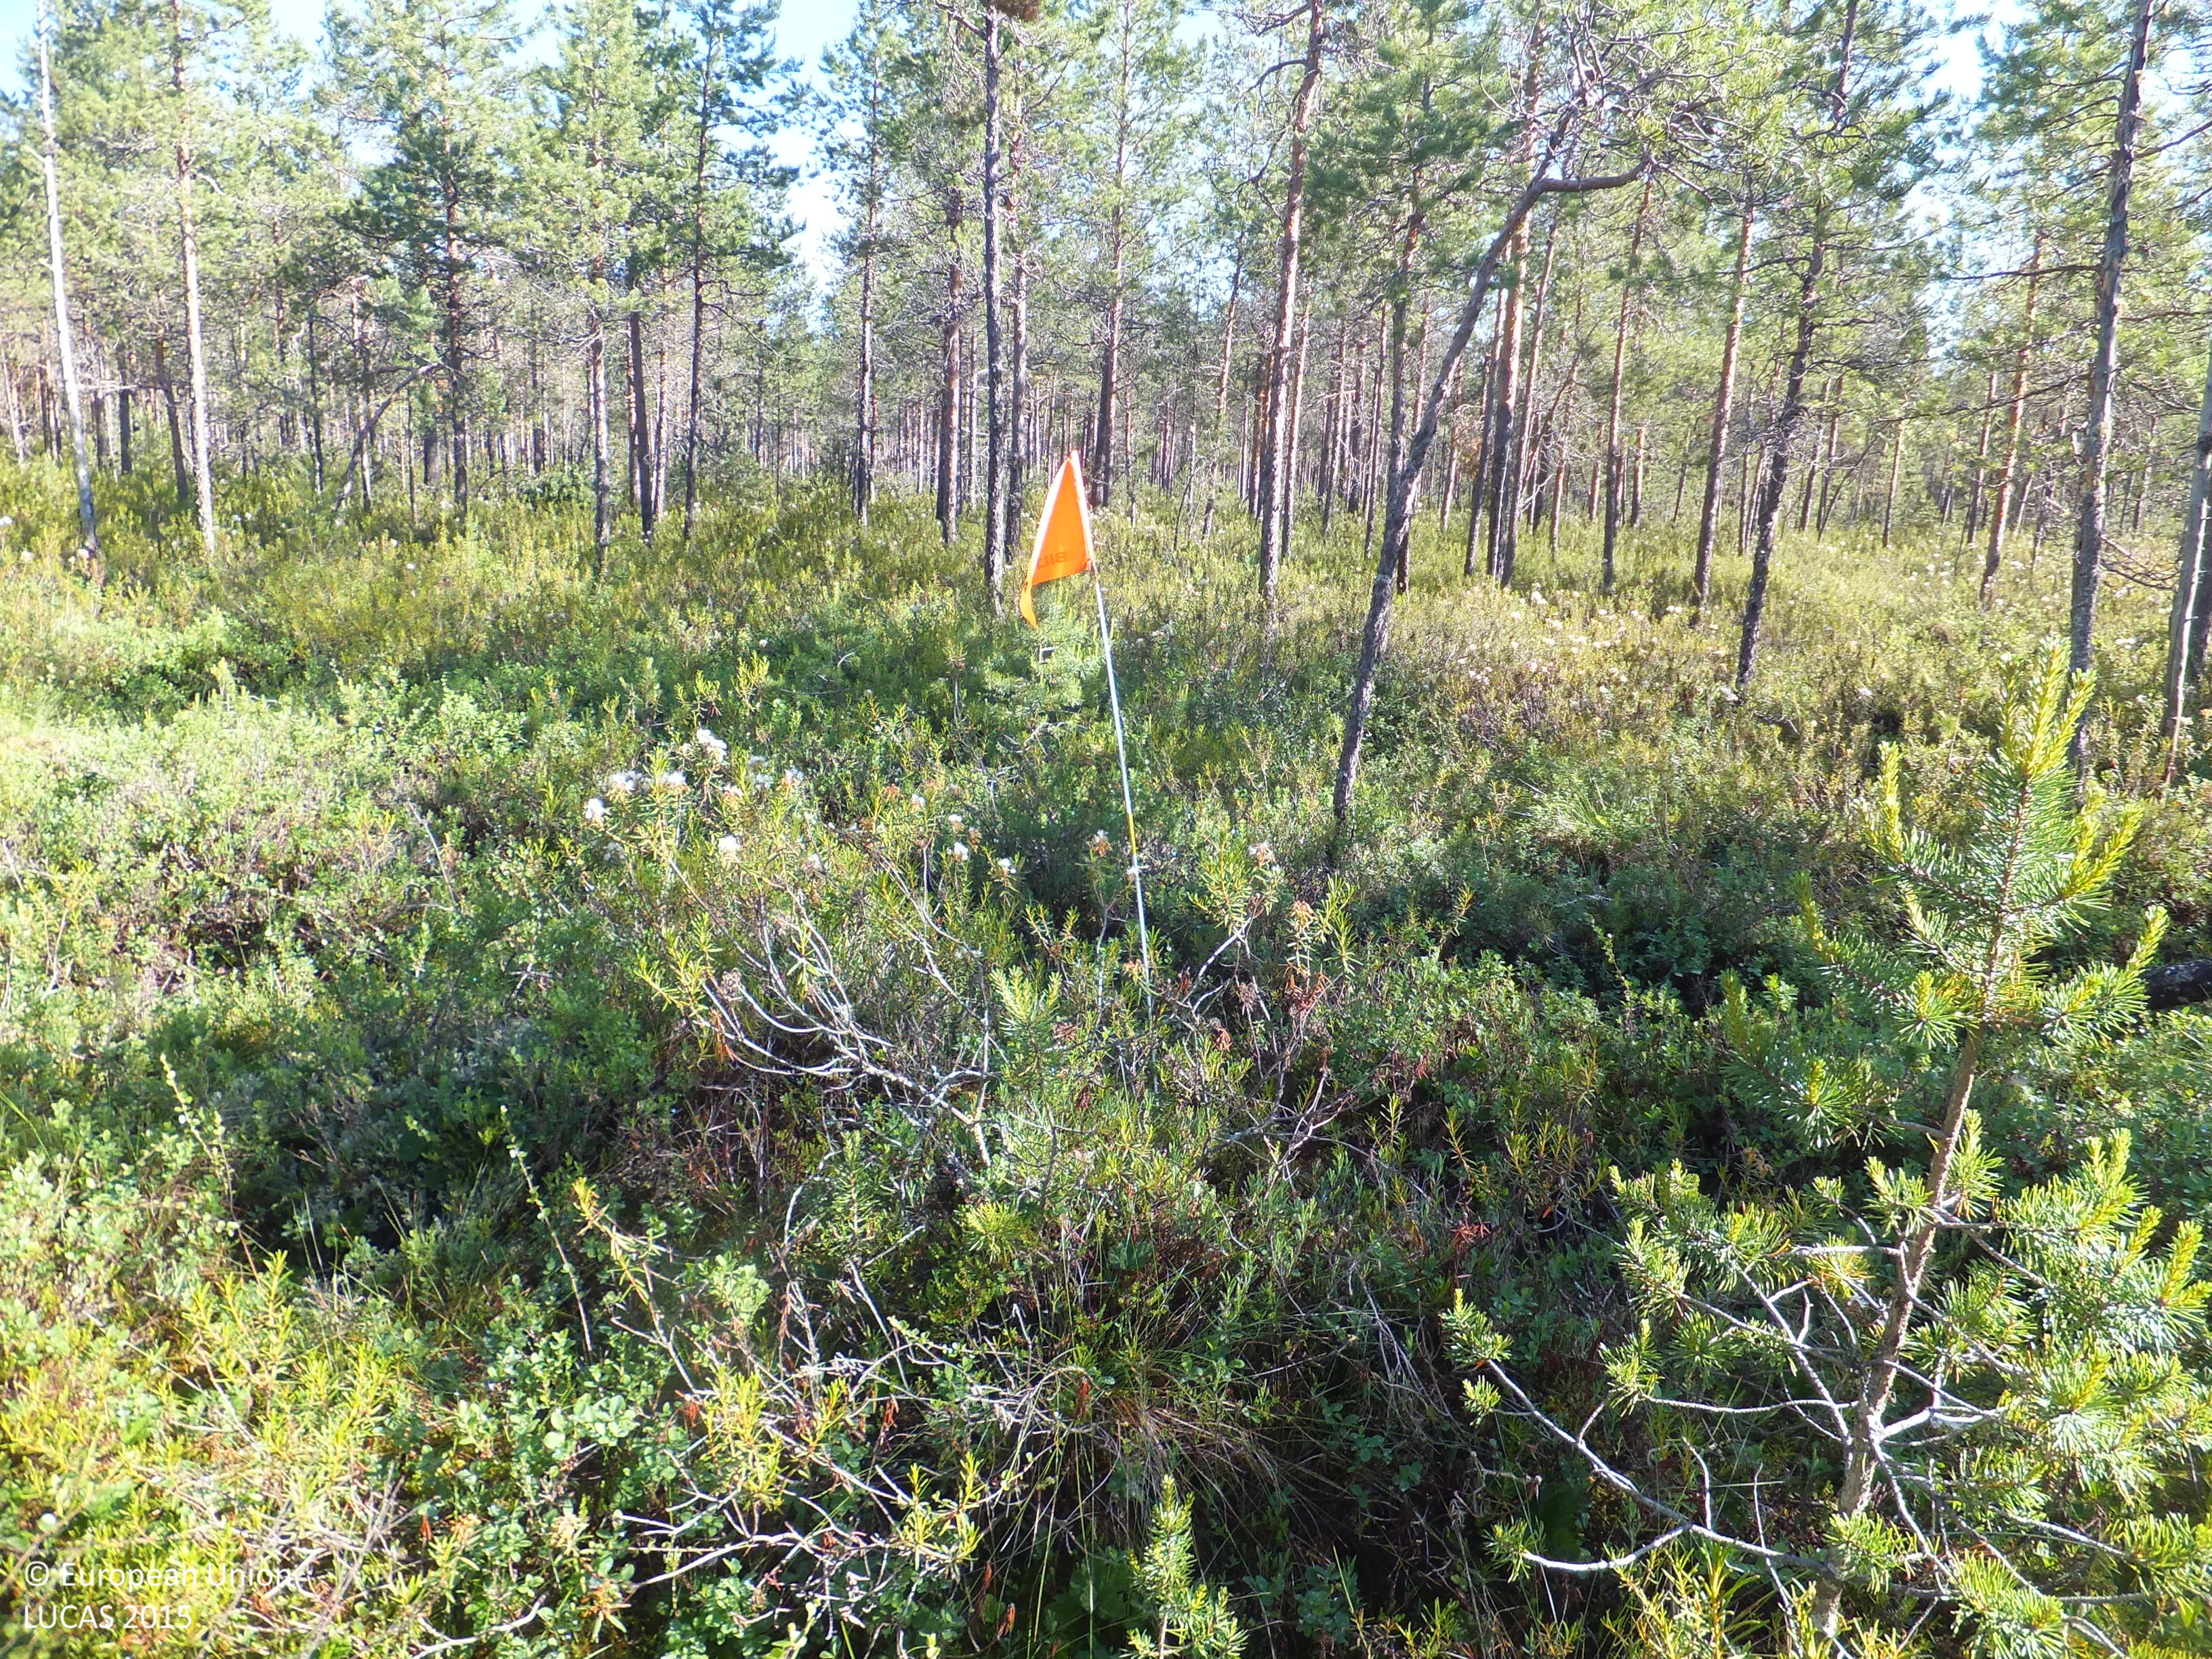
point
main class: Woodland
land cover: Pine dominated coniferous woodland
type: mire and swamp forests
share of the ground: 50 - 75 %
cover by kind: coniferous forest trees 50 %, shrubs 40 %, lichens and mosses 10 %
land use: Forestry
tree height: > 5 m
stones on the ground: < 10 %
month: July
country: FI
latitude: 63.1708
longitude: 23.9548
